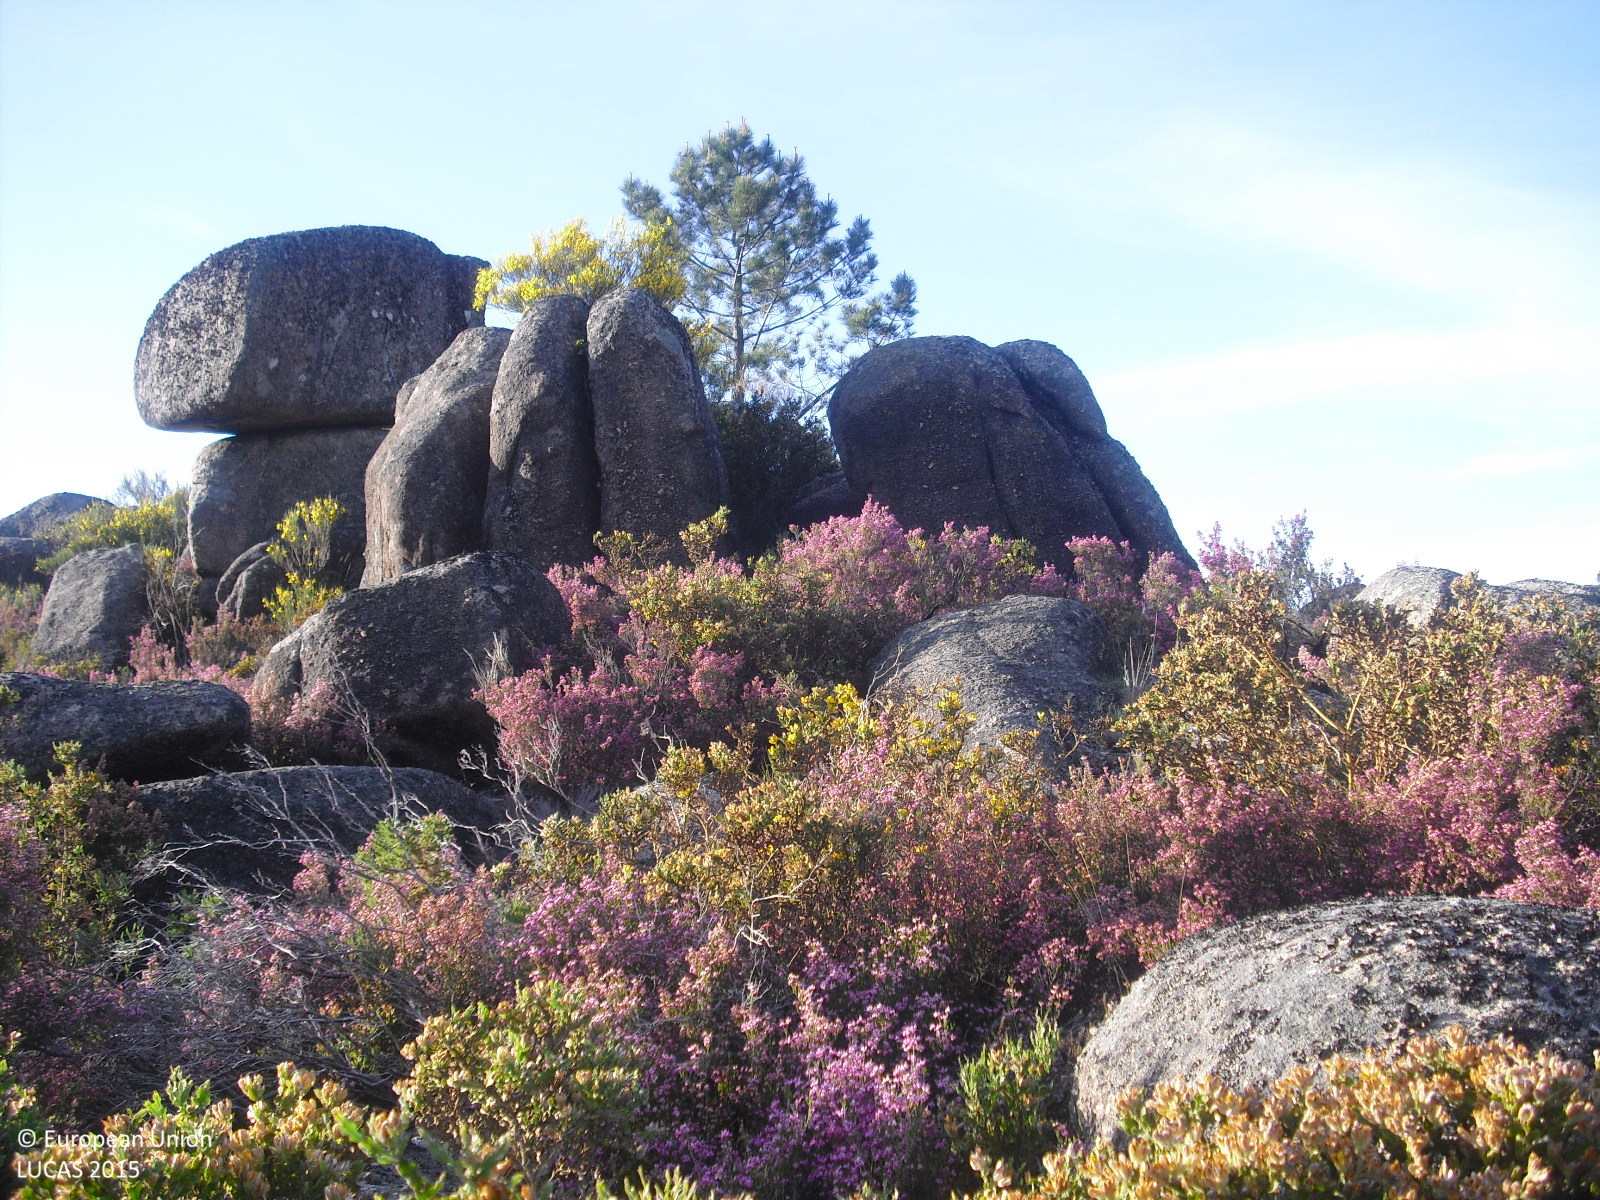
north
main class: Shrubland
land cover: Shrubland with sparse tree cover
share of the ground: > 75 %
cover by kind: shrubs 75 %, consolidated bare surface 20 %, coniferous forest trees 5 %
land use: Semi-natural and natural areas not in use
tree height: < 5 m
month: May
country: ES
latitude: 41.8373
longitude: -8.1040
